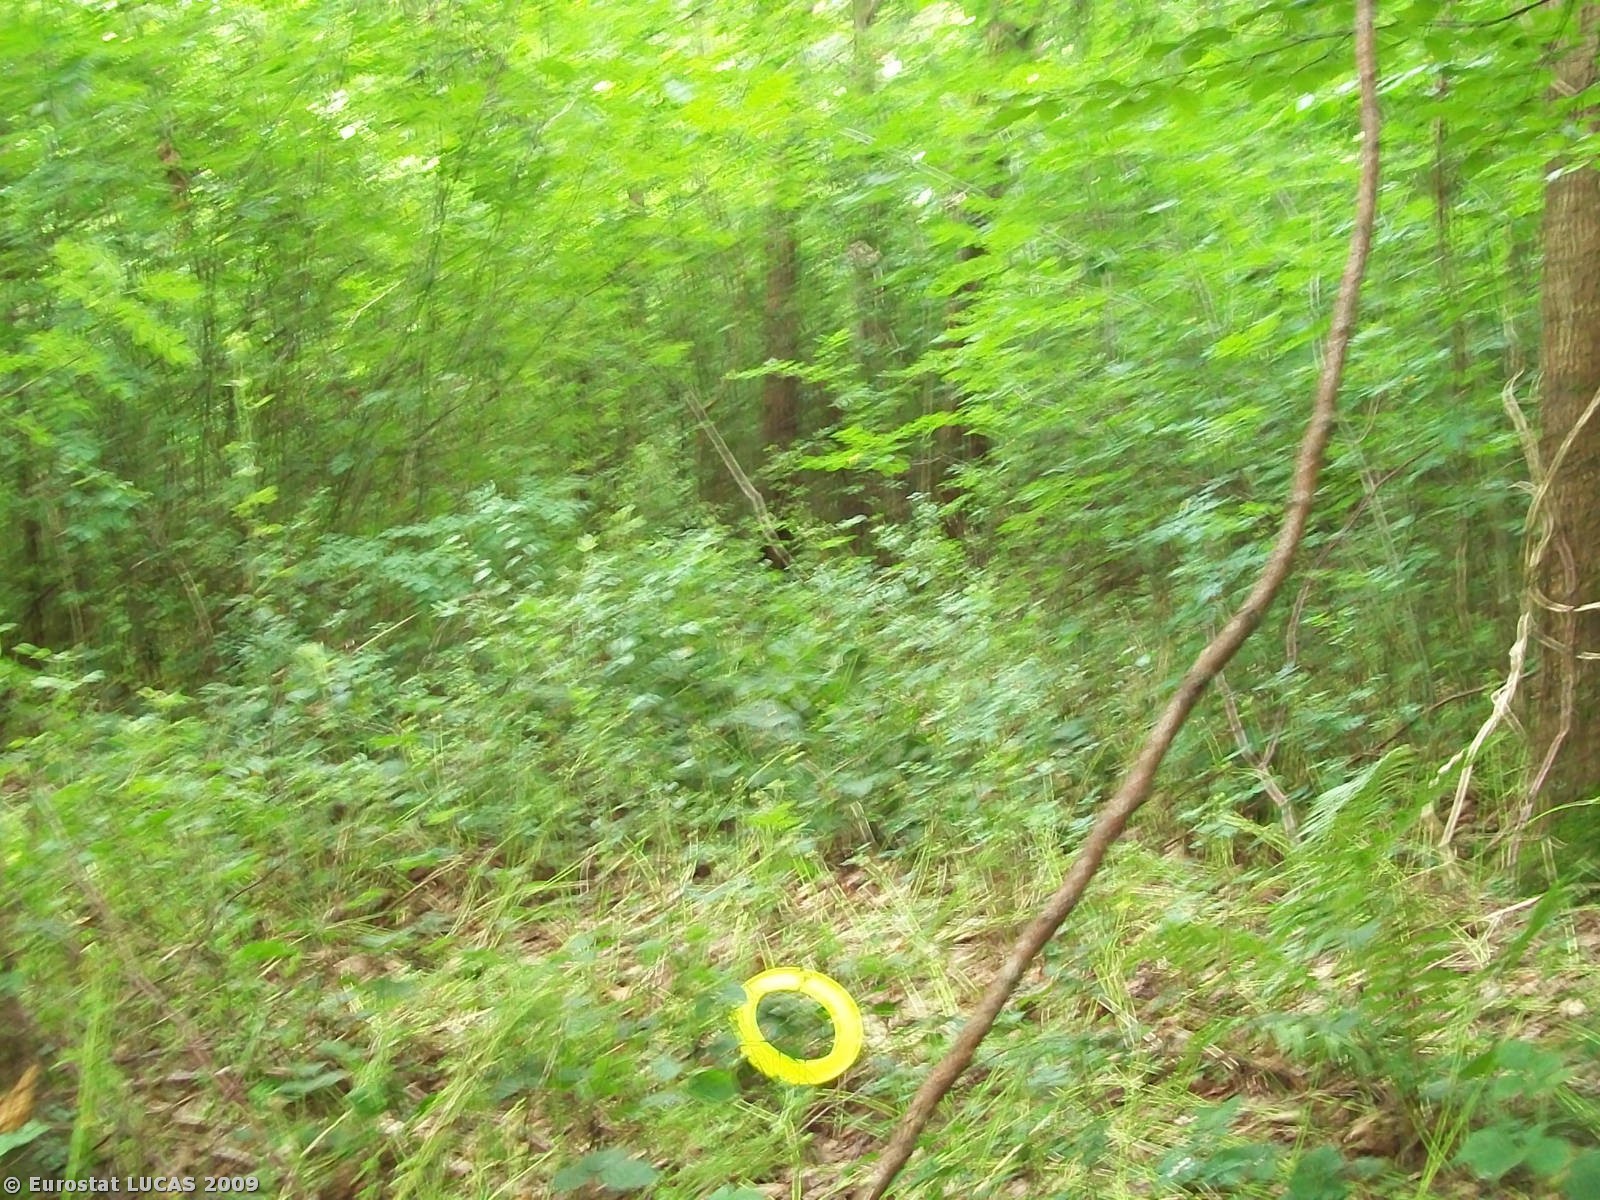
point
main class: Woodland
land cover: Broadleaved woodland
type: mesophytic deciduous forest
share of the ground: > 75 %
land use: Forestry
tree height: > 5 m
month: June
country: GB
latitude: 51.3429
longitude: -2.2215
